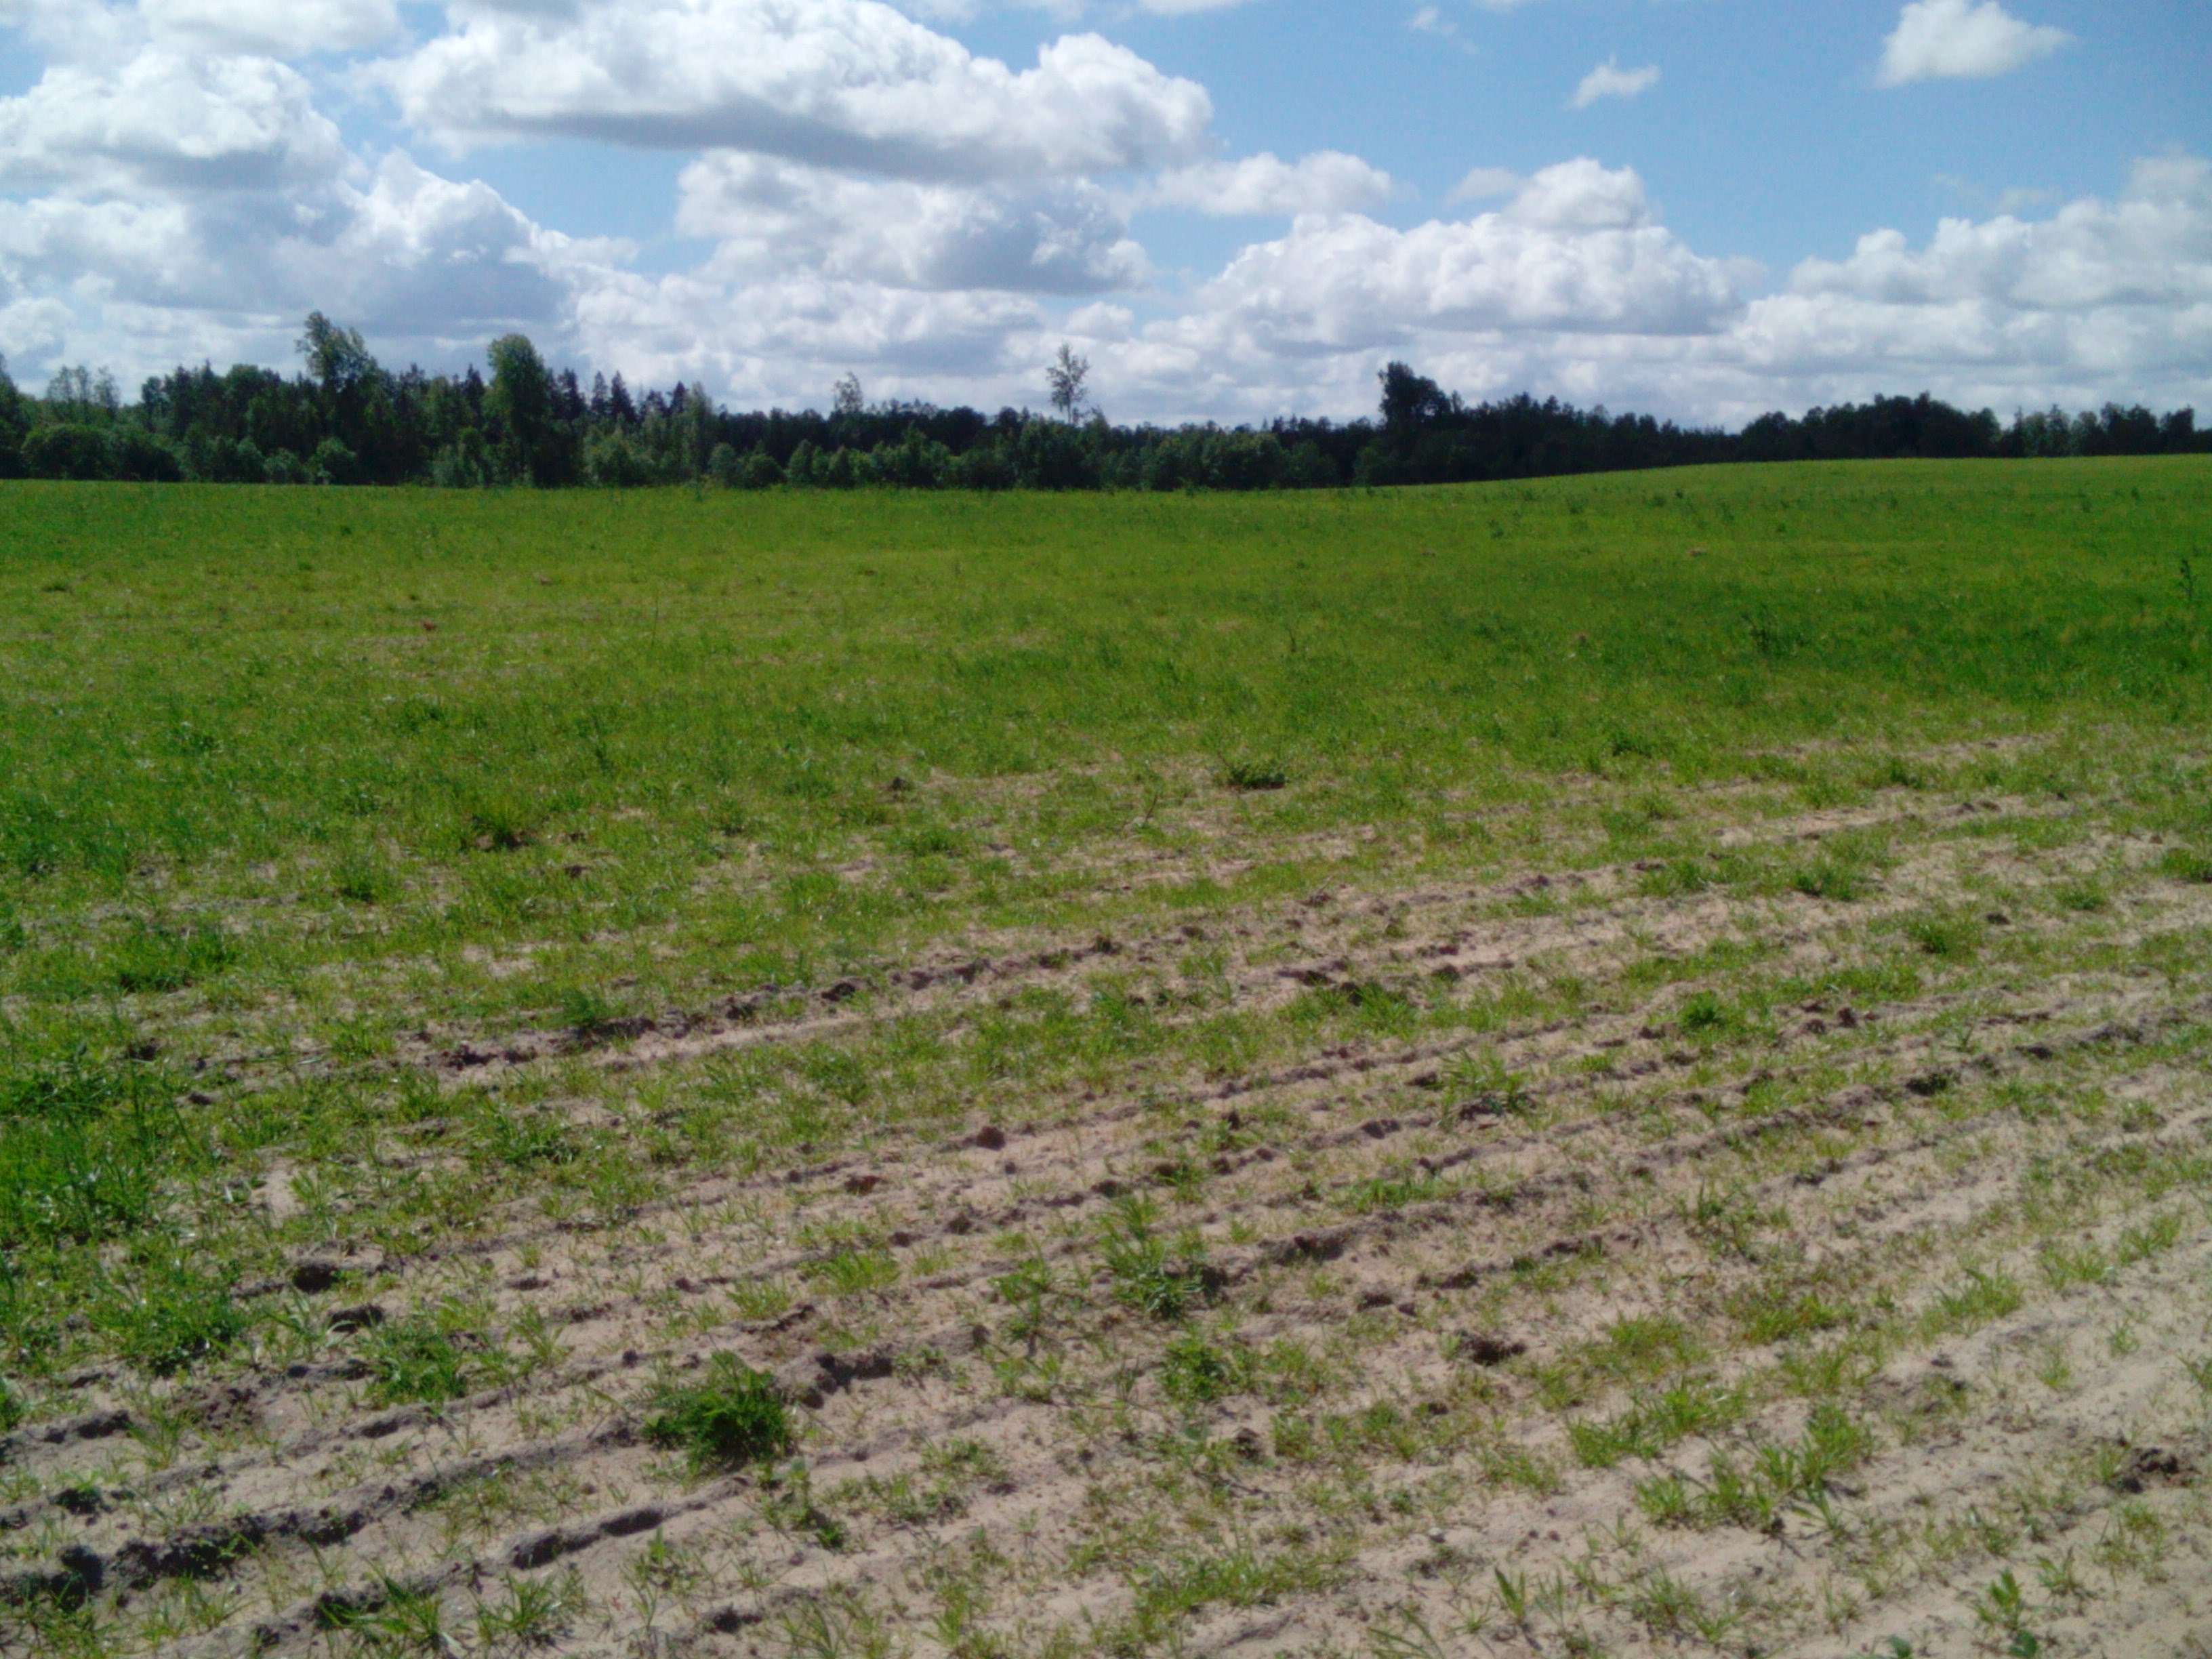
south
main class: Grassland
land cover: Spontaneously vegetated surfaces
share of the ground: 50 - 75 %
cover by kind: herbaceous plants 60 %, unconsolidated bare surface 40 %
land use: Fallow land
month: June
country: LV
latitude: 56.8182
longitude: 22.0576
